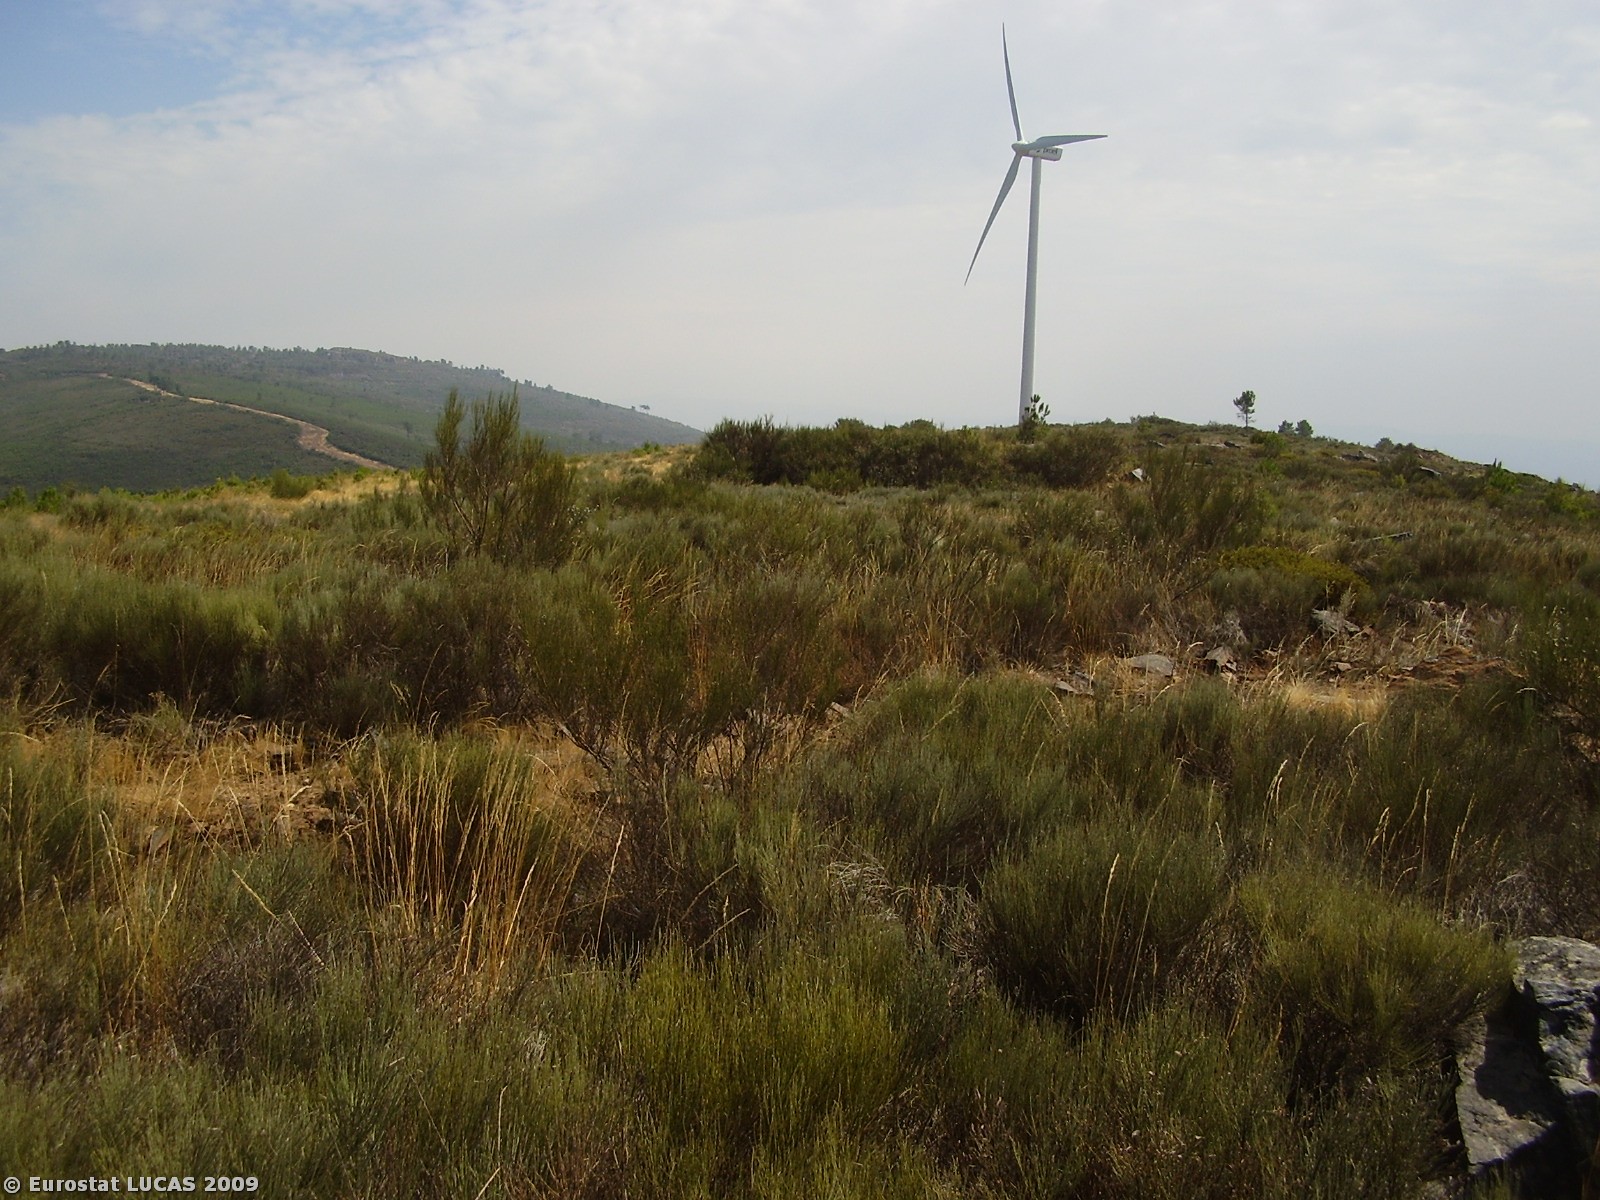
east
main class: Shrubland
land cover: Shrubland with sparse tree cover
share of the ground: > 75 %
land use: Fallow land
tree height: > 5 m
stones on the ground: 25 - 50 %
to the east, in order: Shrubland with sparse tree cover; Rock outcrops; Shrubland with sparse tree cover; Tracks; Shrubland with sparse tree cover
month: September
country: PT
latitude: 41.1720
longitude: -6.9751
